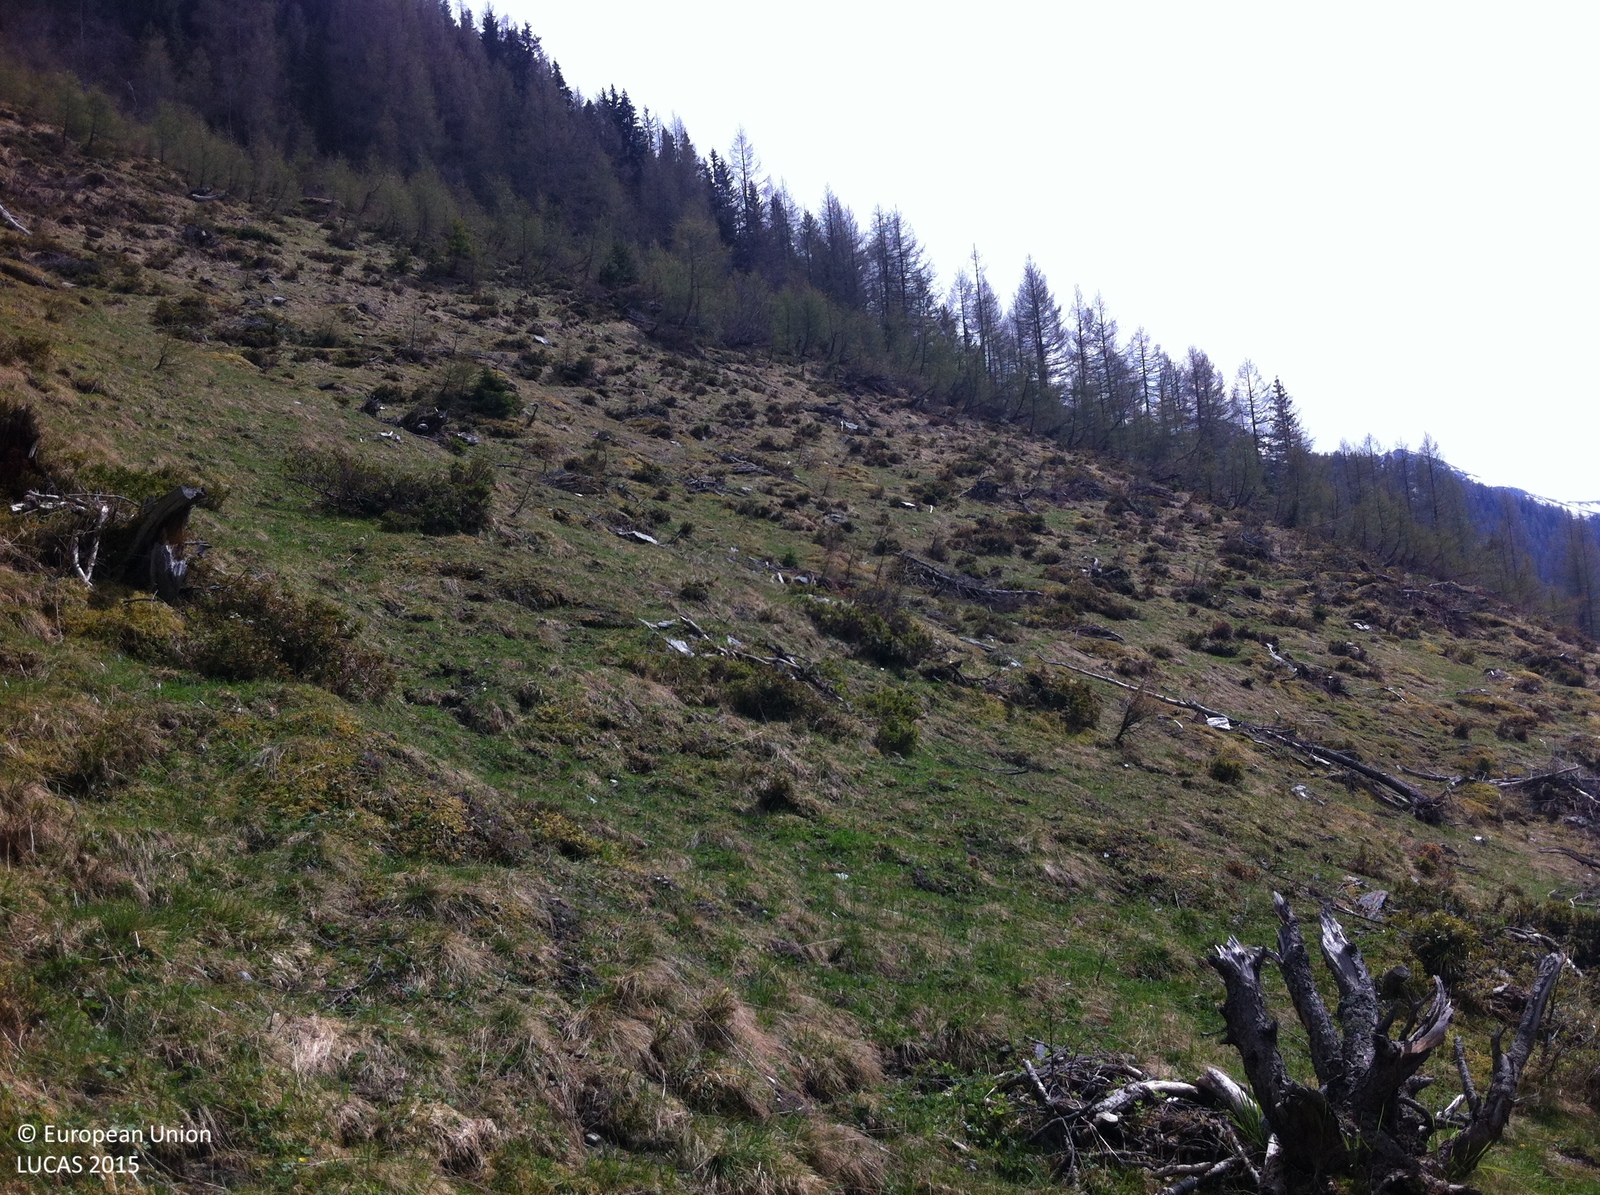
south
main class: Shrubland
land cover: Shrubland with sparse tree cover
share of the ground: 50 - 75 %
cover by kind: shrubs 50 %, herbaceous plants 35 %, lichens and mosses 10 %, coniferous forest trees 5 %
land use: Forestry
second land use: Agriculture (excluding fallow land and kitchen gardens)
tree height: < 5 m
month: May
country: AT
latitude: 47.0958
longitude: 11.5926
